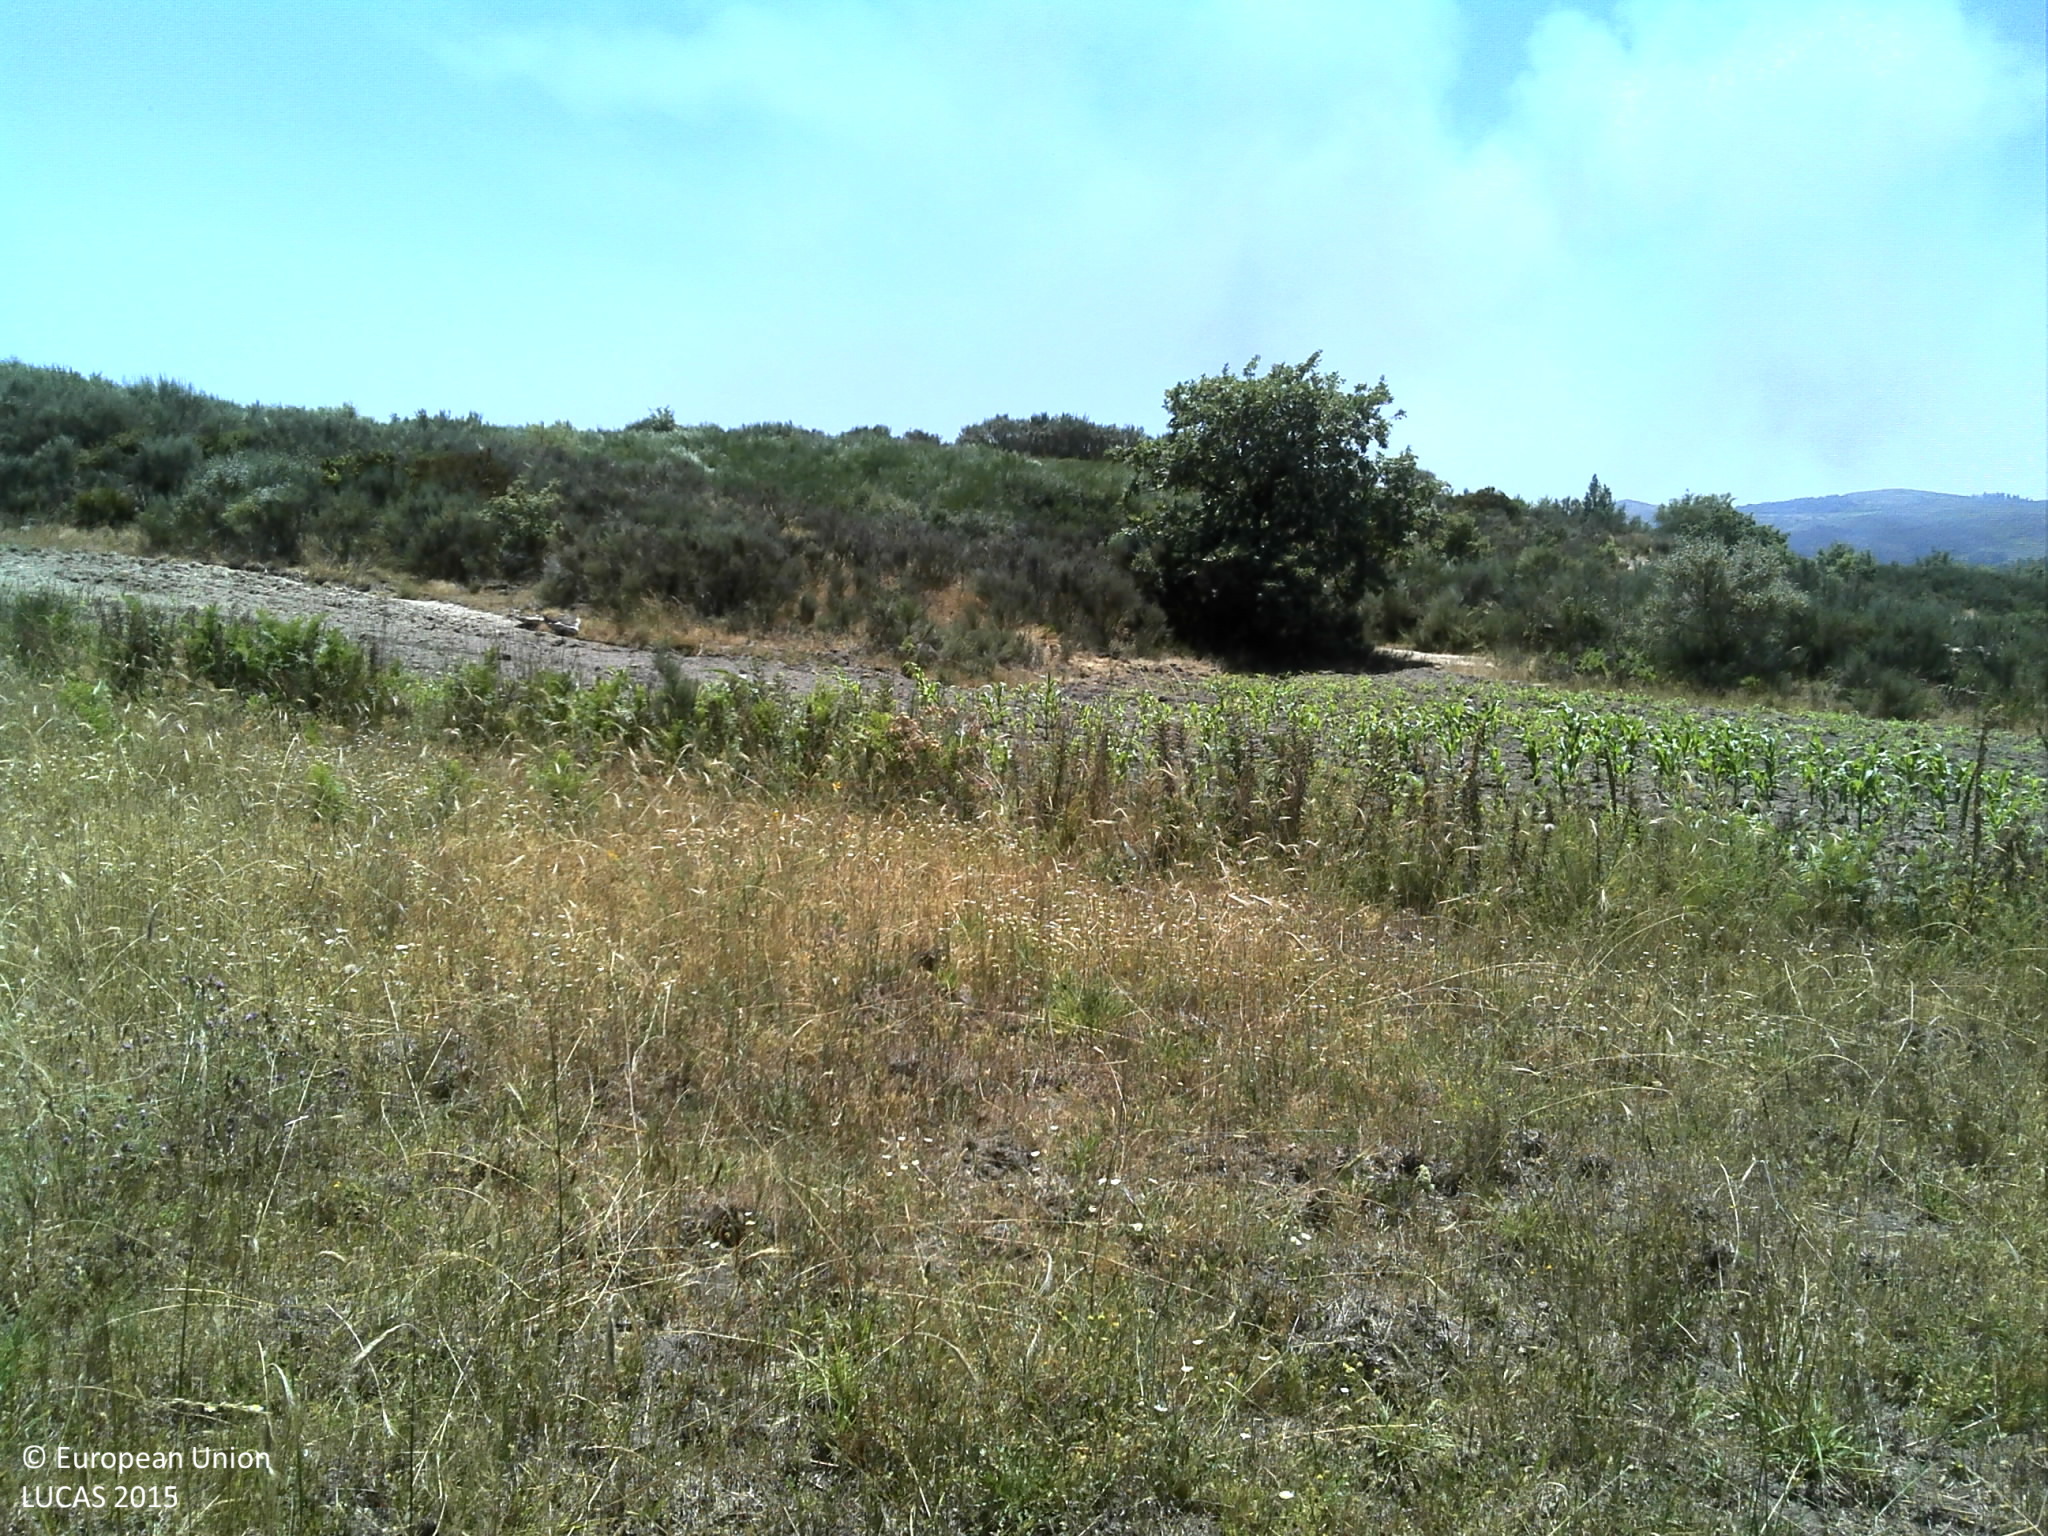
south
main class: Grassland
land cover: Grassland without tree/shrub cover
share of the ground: > 75 %
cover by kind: herbaceous plants 95 %, unconsolidated bare surface 5 %
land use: Agriculture (excluding fallow land and kitchen gardens)
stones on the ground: < 10 %
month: July
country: PT
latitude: 41.8089
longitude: -7.6496
